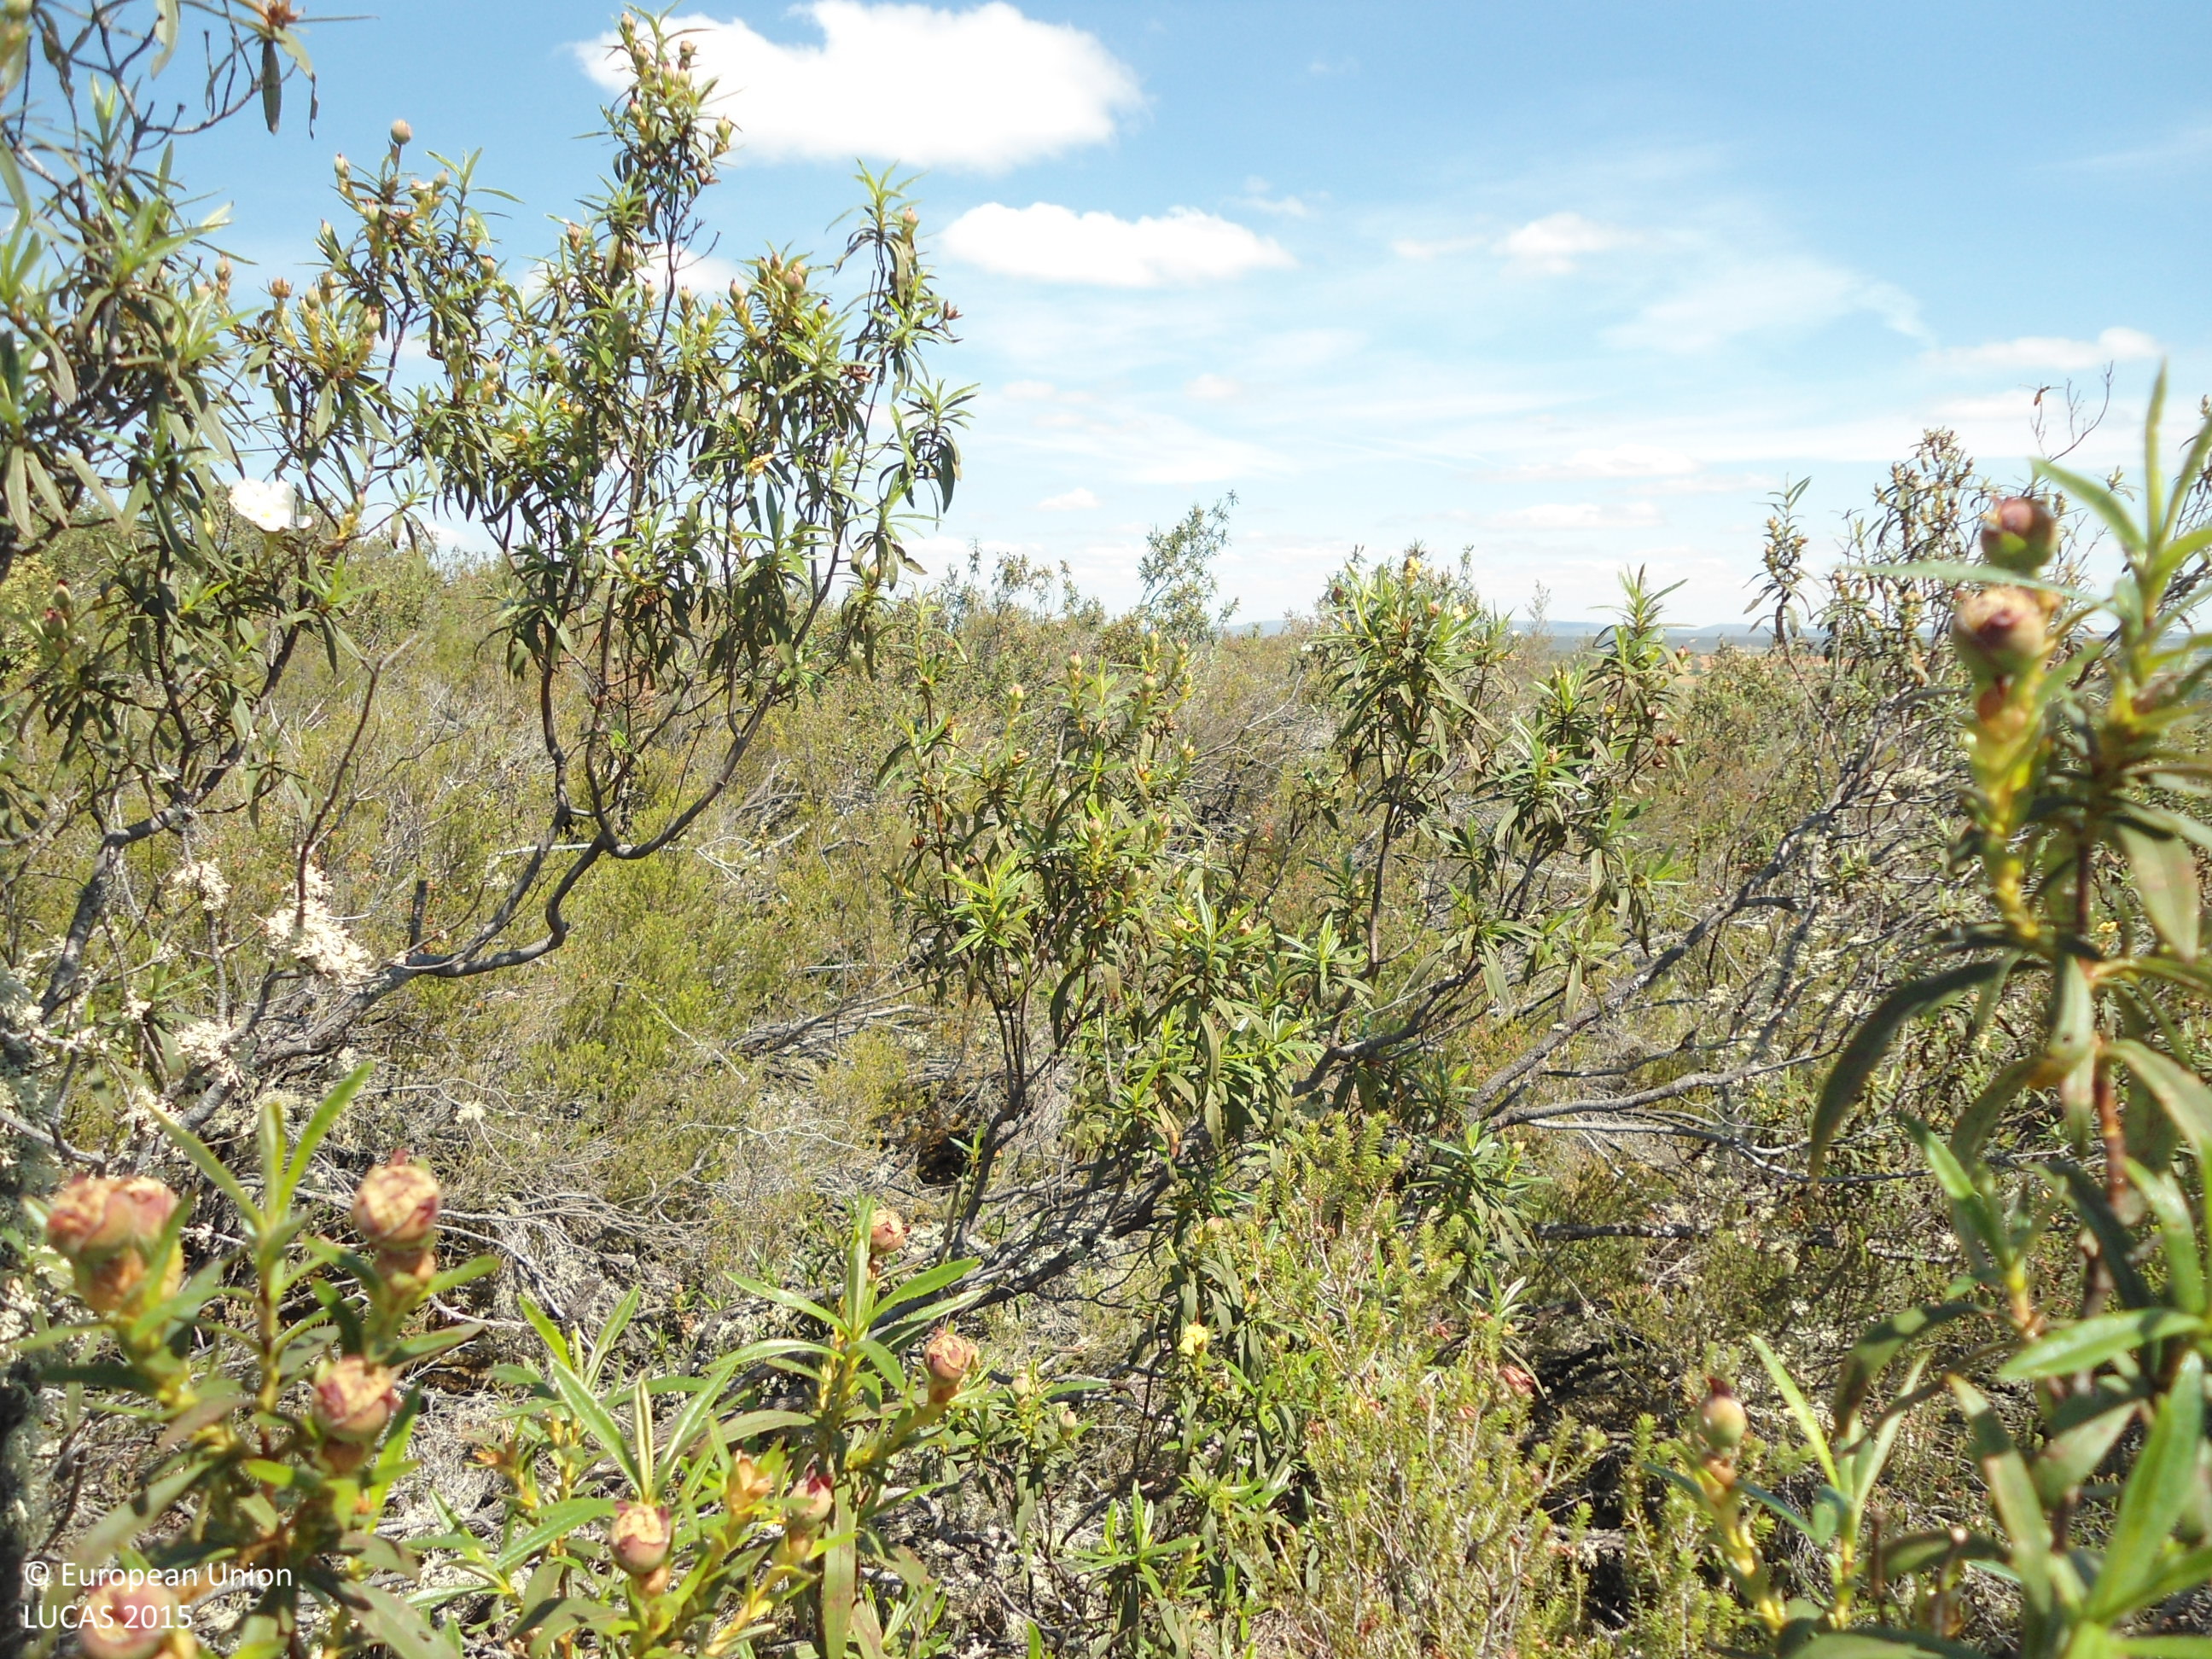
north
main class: Shrubland
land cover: Shrubland with sparse tree cover
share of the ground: > 75 %
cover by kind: shrubs 95 %, broadleaved forest trees 5 %
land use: Semi-natural and natural areas not in use
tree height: < 5 m
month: May
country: ES
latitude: 41.8995
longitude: -5.9223
